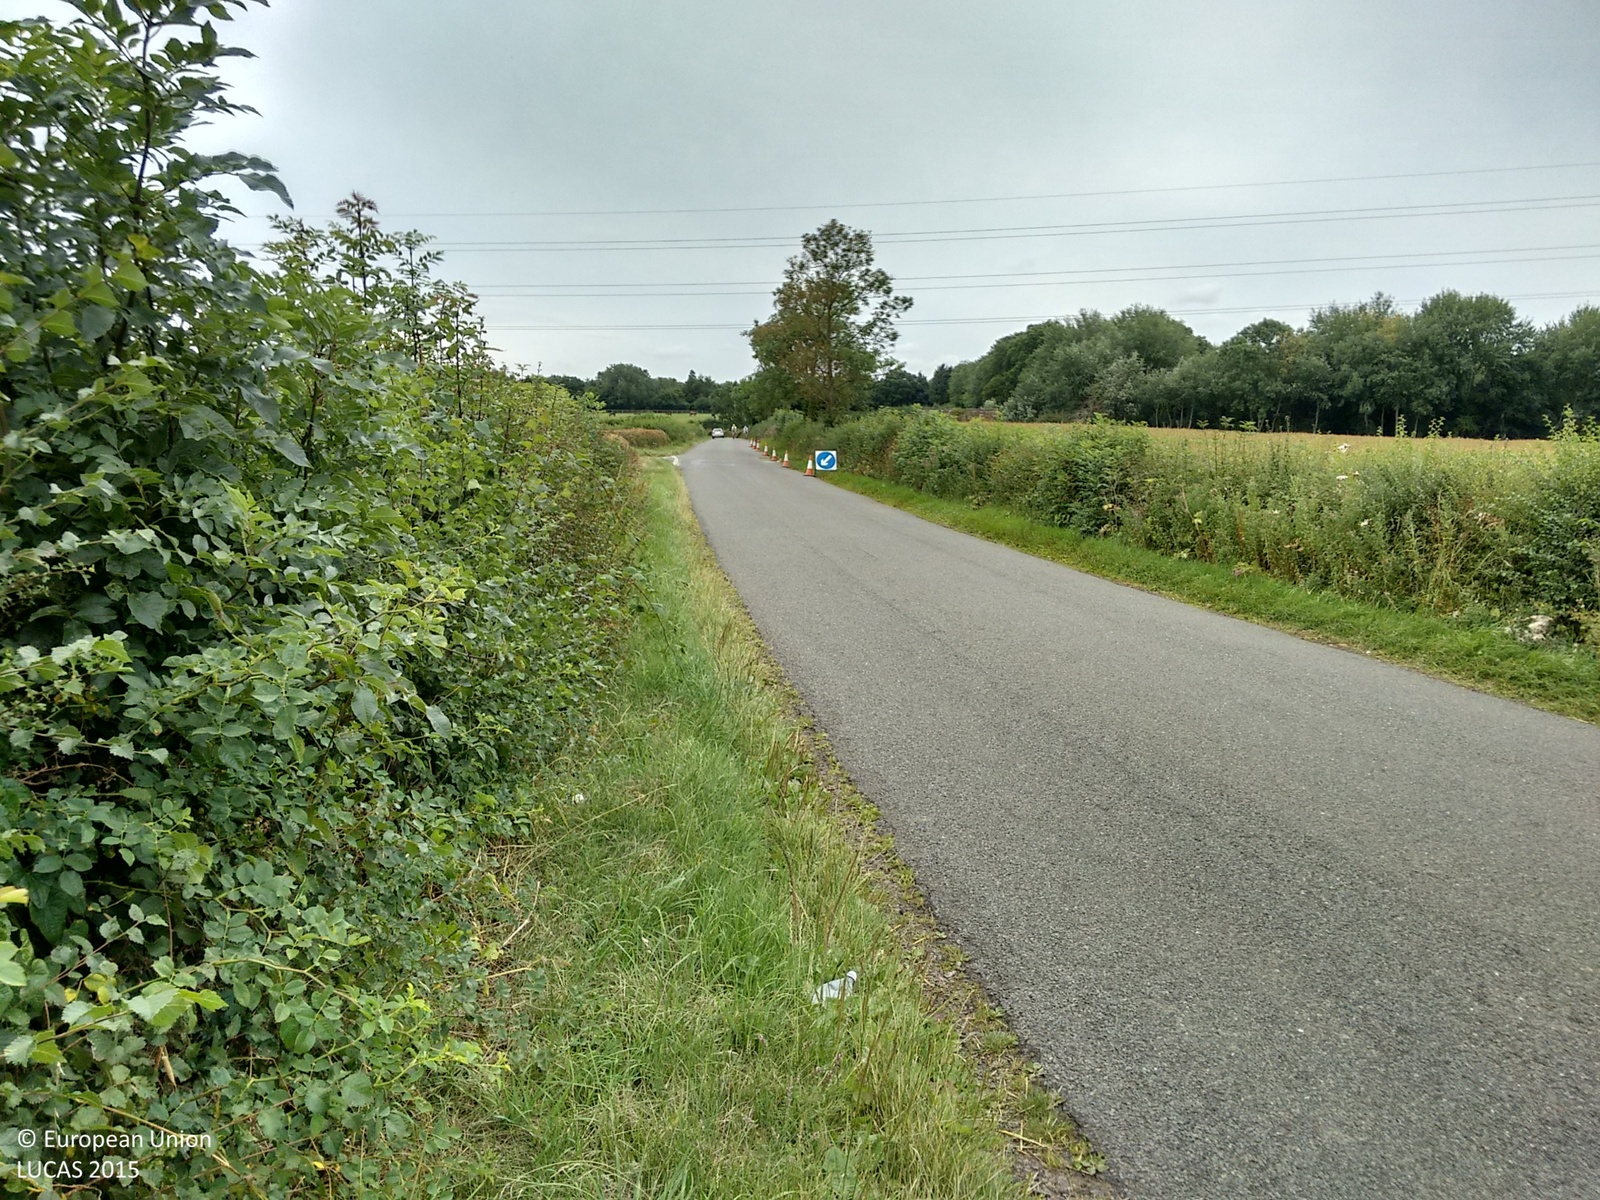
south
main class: Cropland
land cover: Maize
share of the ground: > 75 %
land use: Agriculture (excluding fallow land and kitchen gardens)
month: August
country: GB
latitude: 52.0806
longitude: -1.2101
